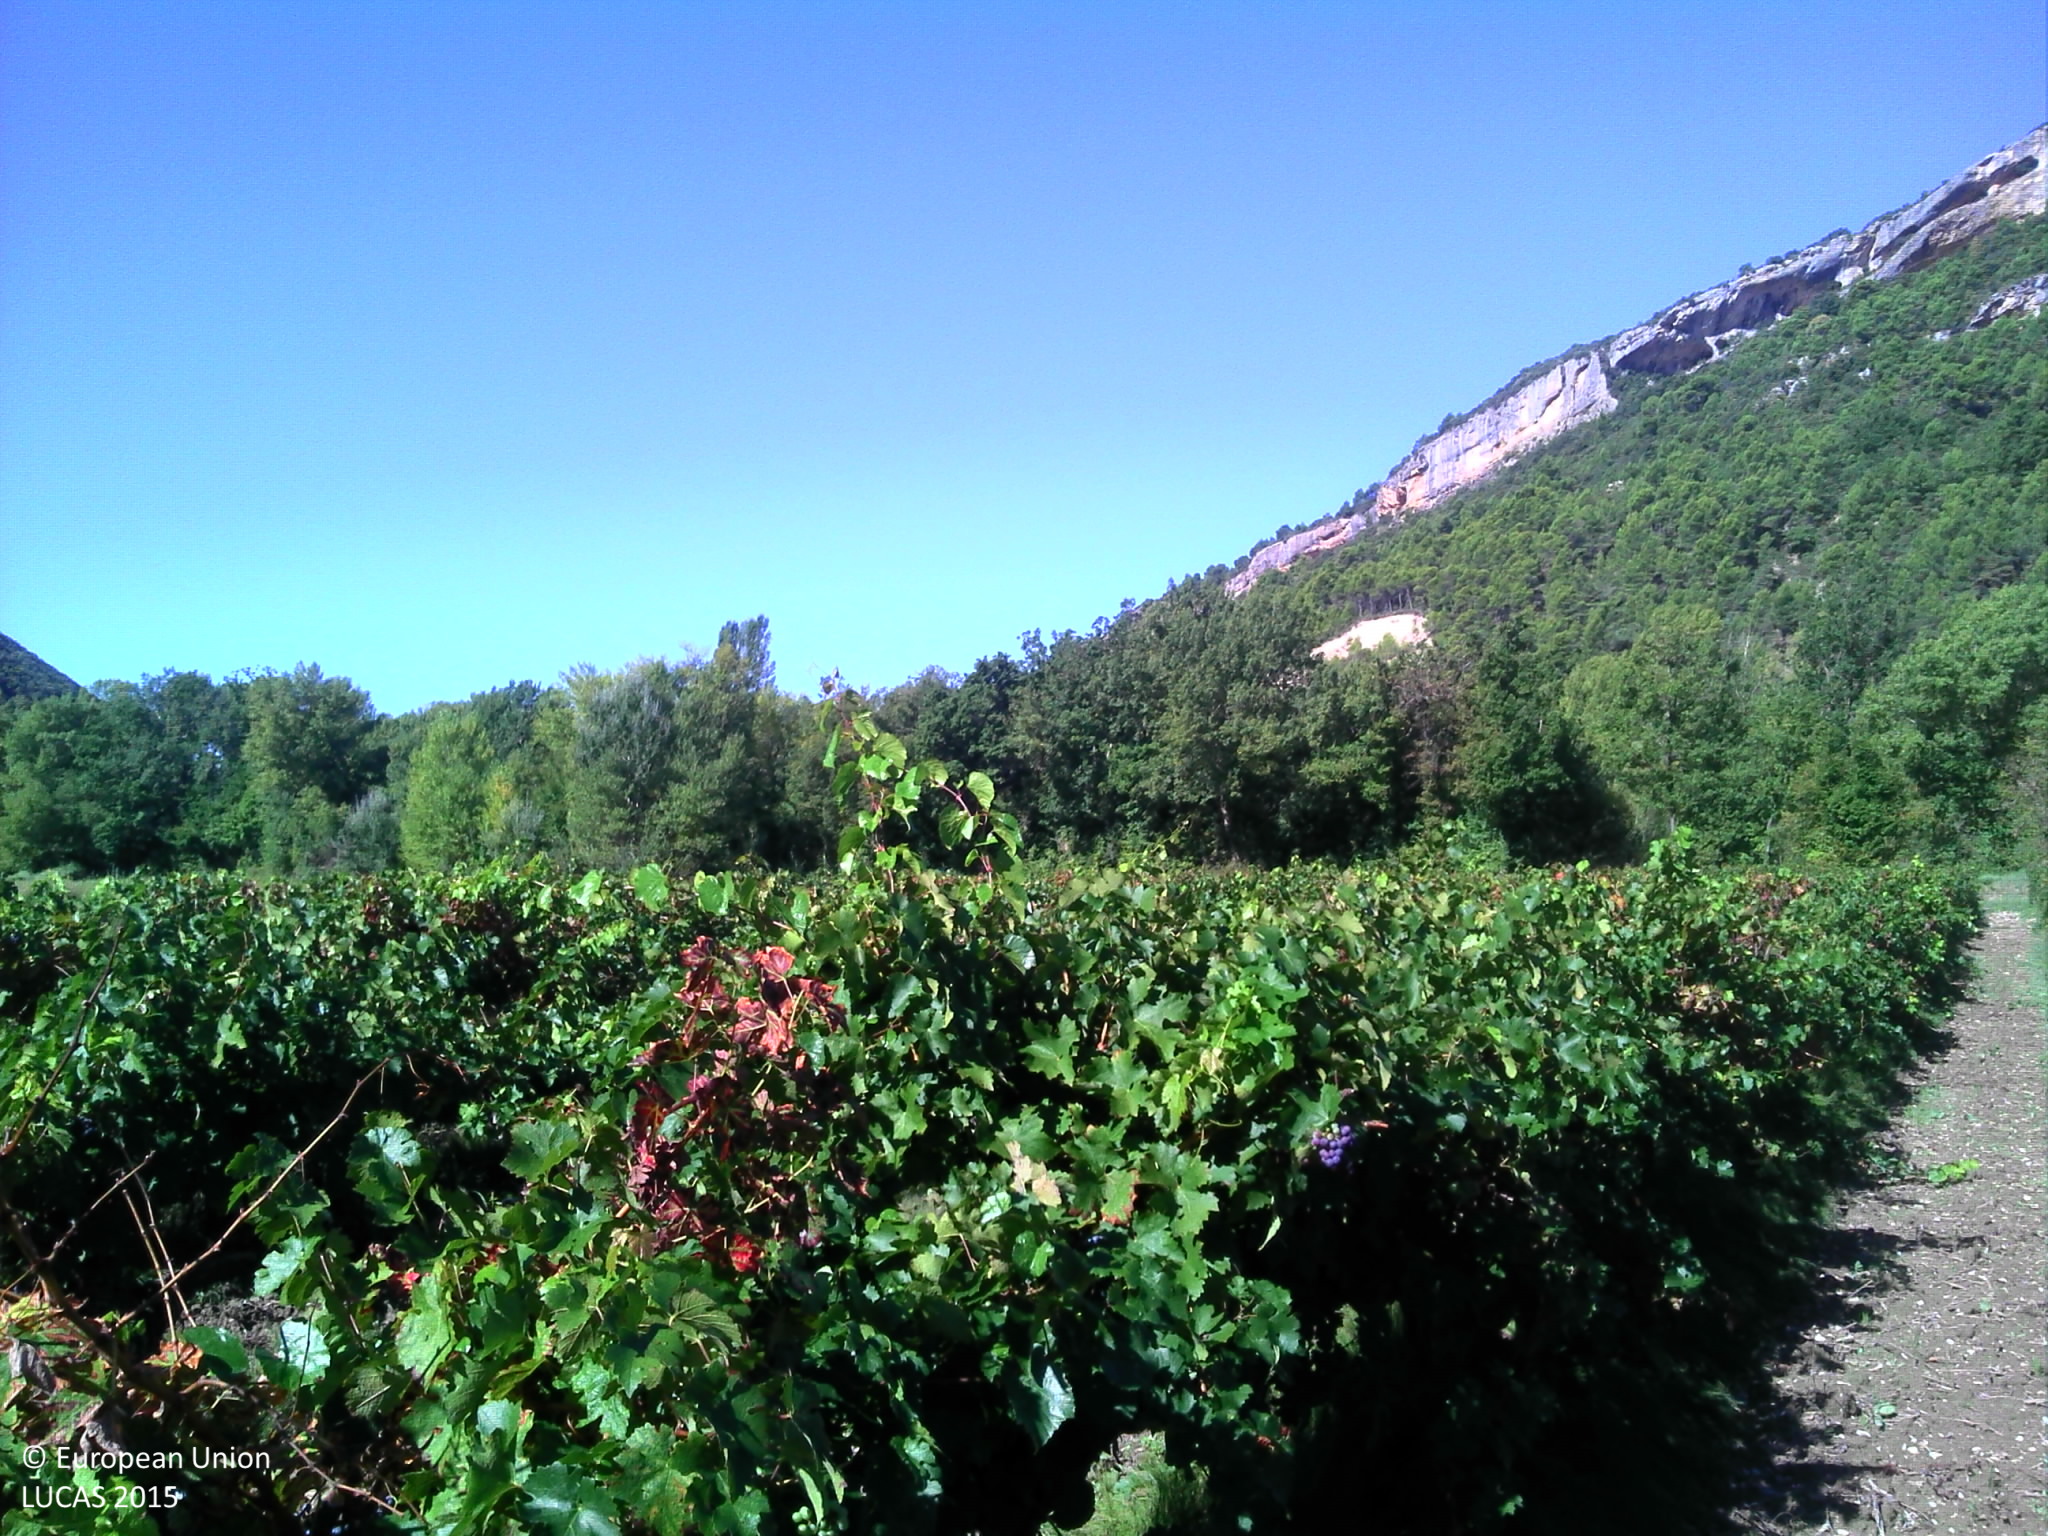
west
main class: Cropland
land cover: Vineyards
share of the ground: 50 - 75 %
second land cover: Spontaneously vegetated surfaces
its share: 10 - 25 %
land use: Agriculture (excluding fallow land and kitchen gardens)
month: September
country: FR
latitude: 44.2401
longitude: 5.2120
